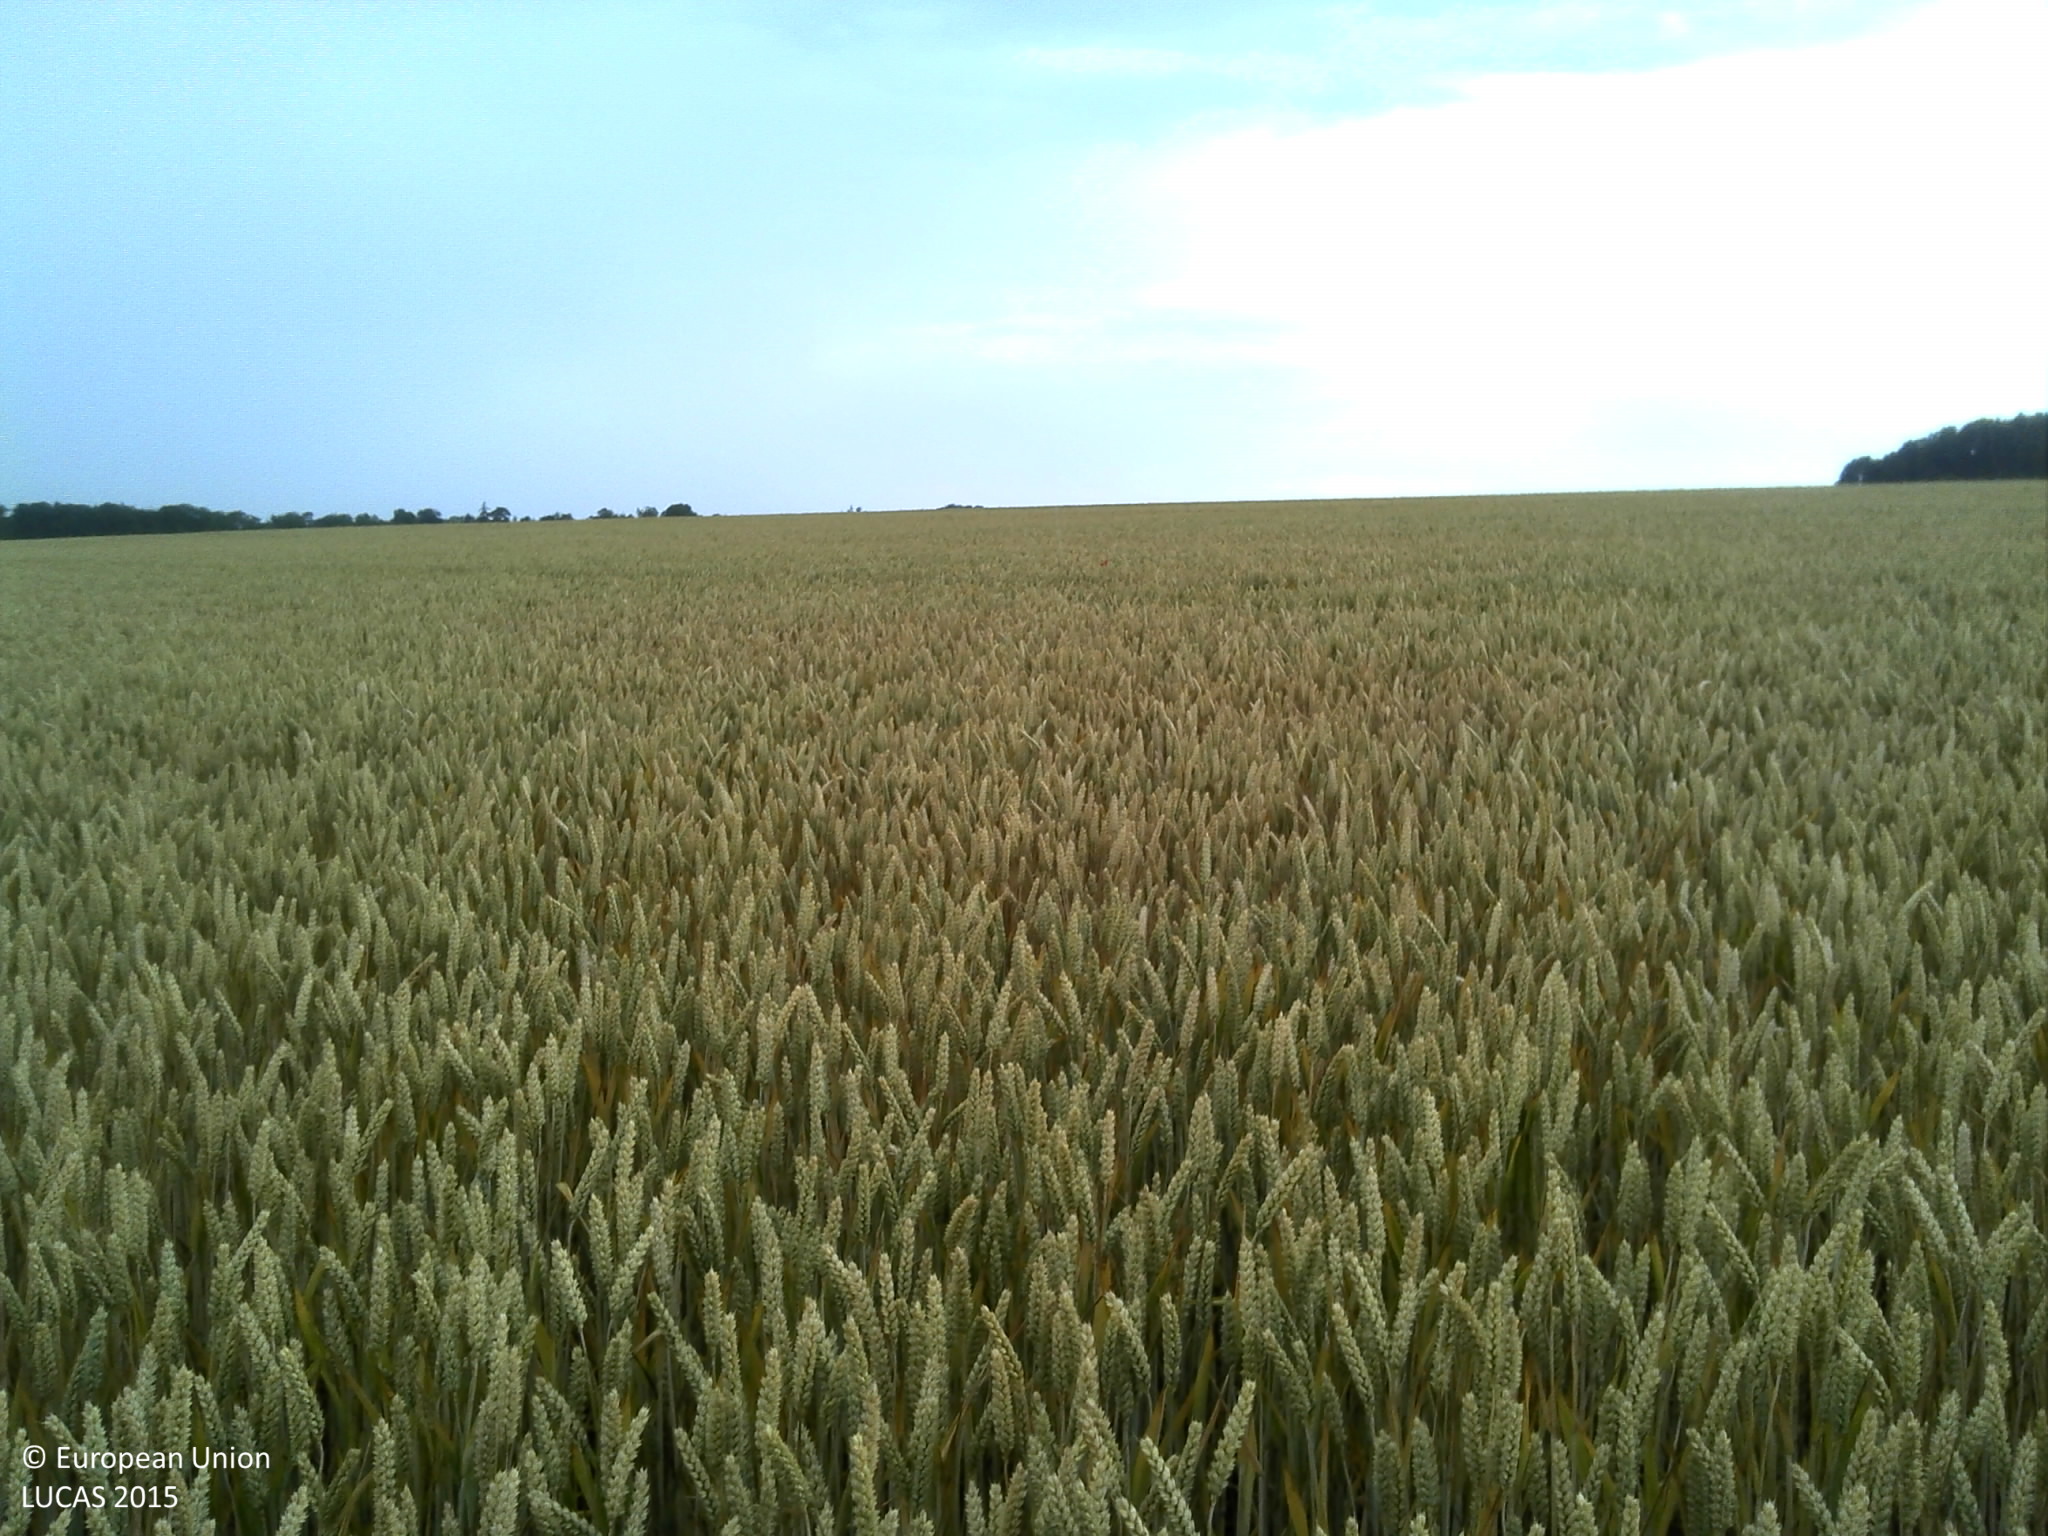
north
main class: Cropland
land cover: Common wheat
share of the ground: > 75 %
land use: Agriculture (excluding fallow land and kitchen gardens)
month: July
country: FR
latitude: 49.8351
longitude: 1.0938
